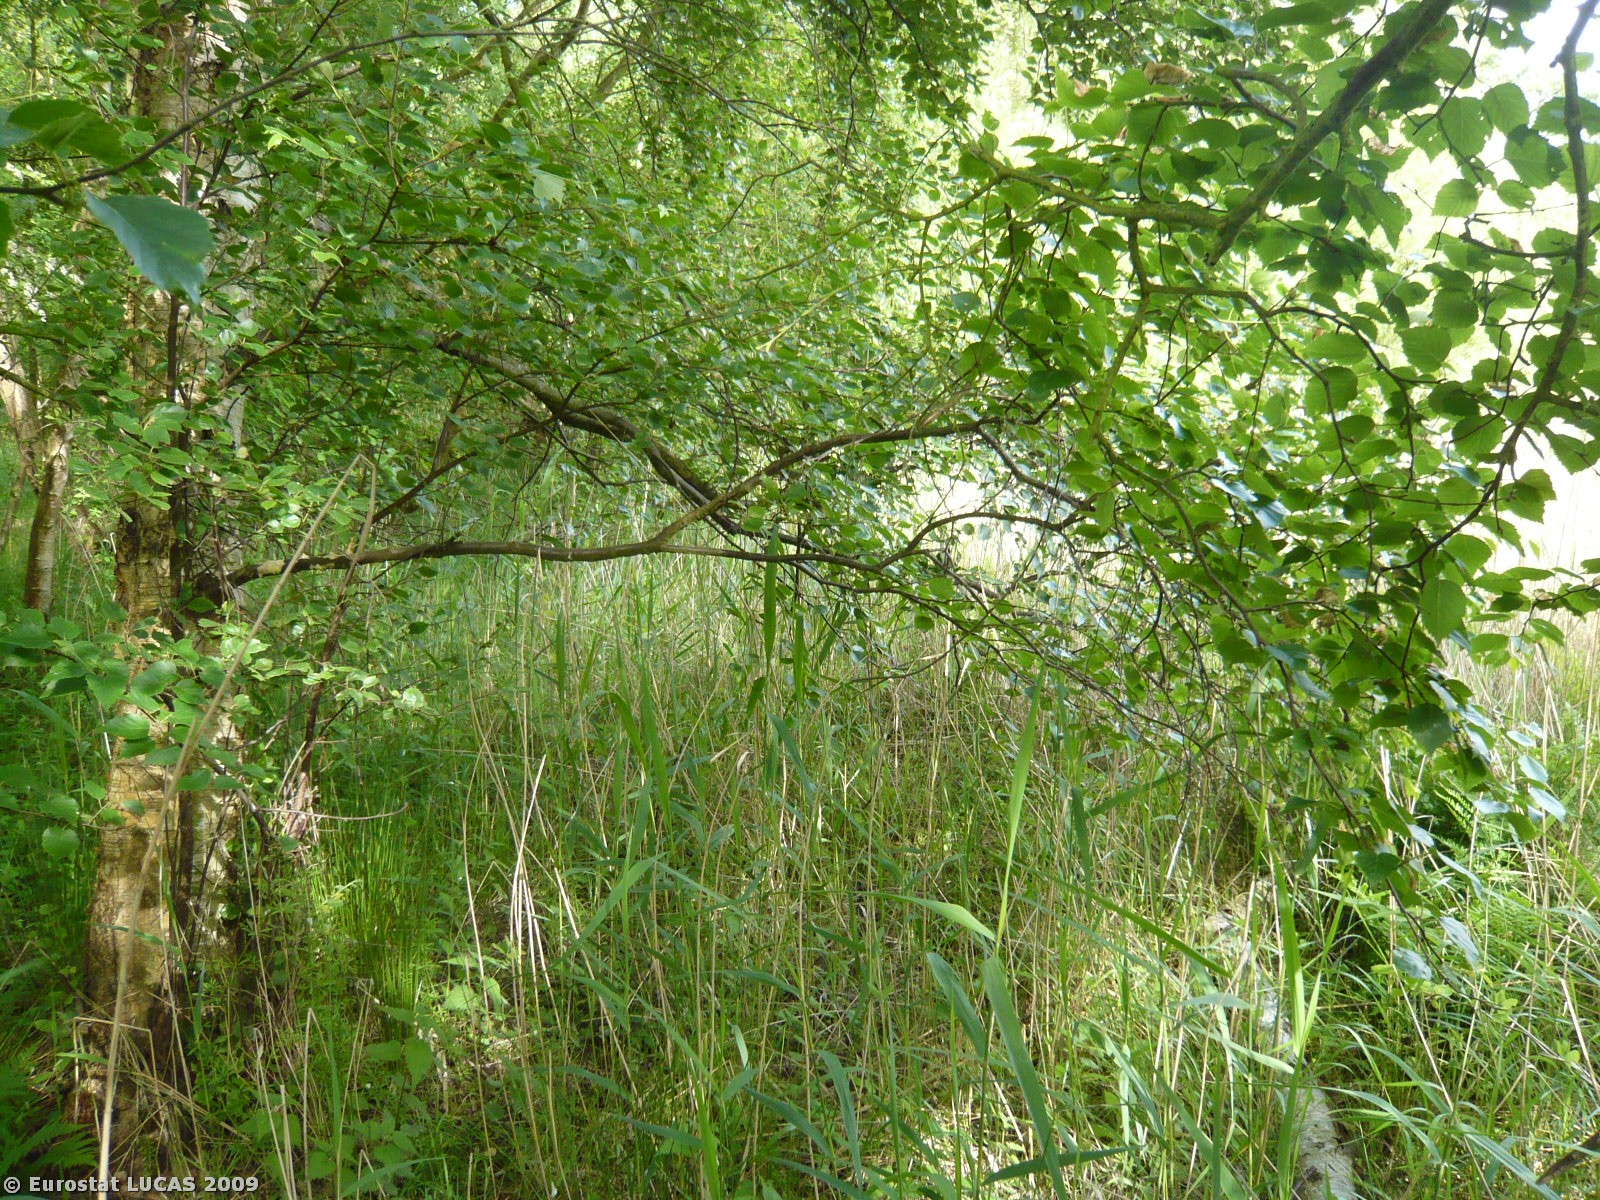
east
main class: Woodland
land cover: Broadleaved woodland
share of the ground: > 75 %
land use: Unused
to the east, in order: Broadleaved woodland; Inland marshes; Broadleaved woodland; Tracks; Mixed woodland; Ditches and canals; Grassland without tree/shrub cover; Paved roads, cycling and walking lanes; Grassland without tree/shrub cover; Ditches and canals; Lines of trees; Broadleaved woodland; Shrubland with sparse tree cover; Broadleaved woodland; Grassland without tree/shrub cover; Broadleaved woodland; Paved roads, cycling and walking lanes; Broadleaved woodland
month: June
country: DK
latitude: 54.5905
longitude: 11.9643
